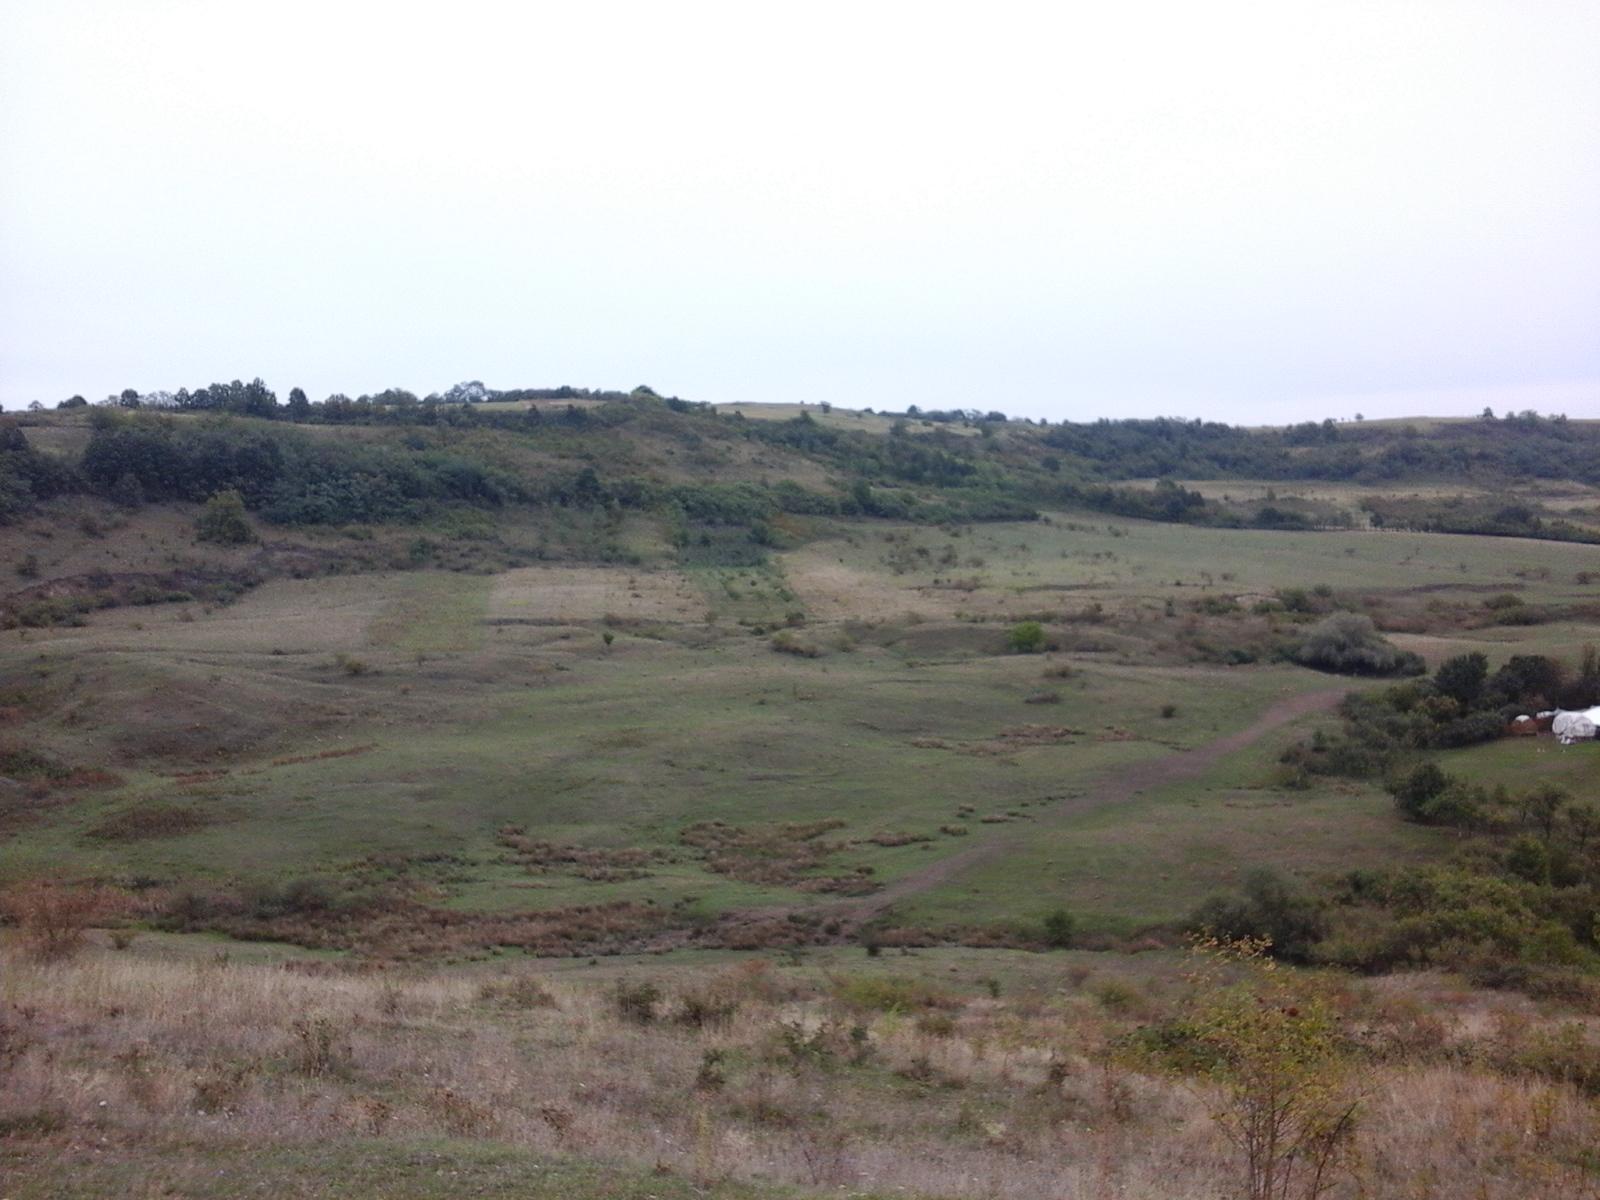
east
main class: Grassland
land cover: Grassland with sparse tree/shrub cover
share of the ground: > 75 %
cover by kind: herbaceous plants 85 %, shrubs 10 %, broadleaved forest trees 5 %
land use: Agriculture (excluding fallow land and kitchen gardens)
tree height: < 5 m
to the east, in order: Grassland with sparse tree/shrub cover; Grassland without tree/shrub cover; Tracks; Broadleaved woodland
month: September
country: RO
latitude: 47.3259
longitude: 22.5071
